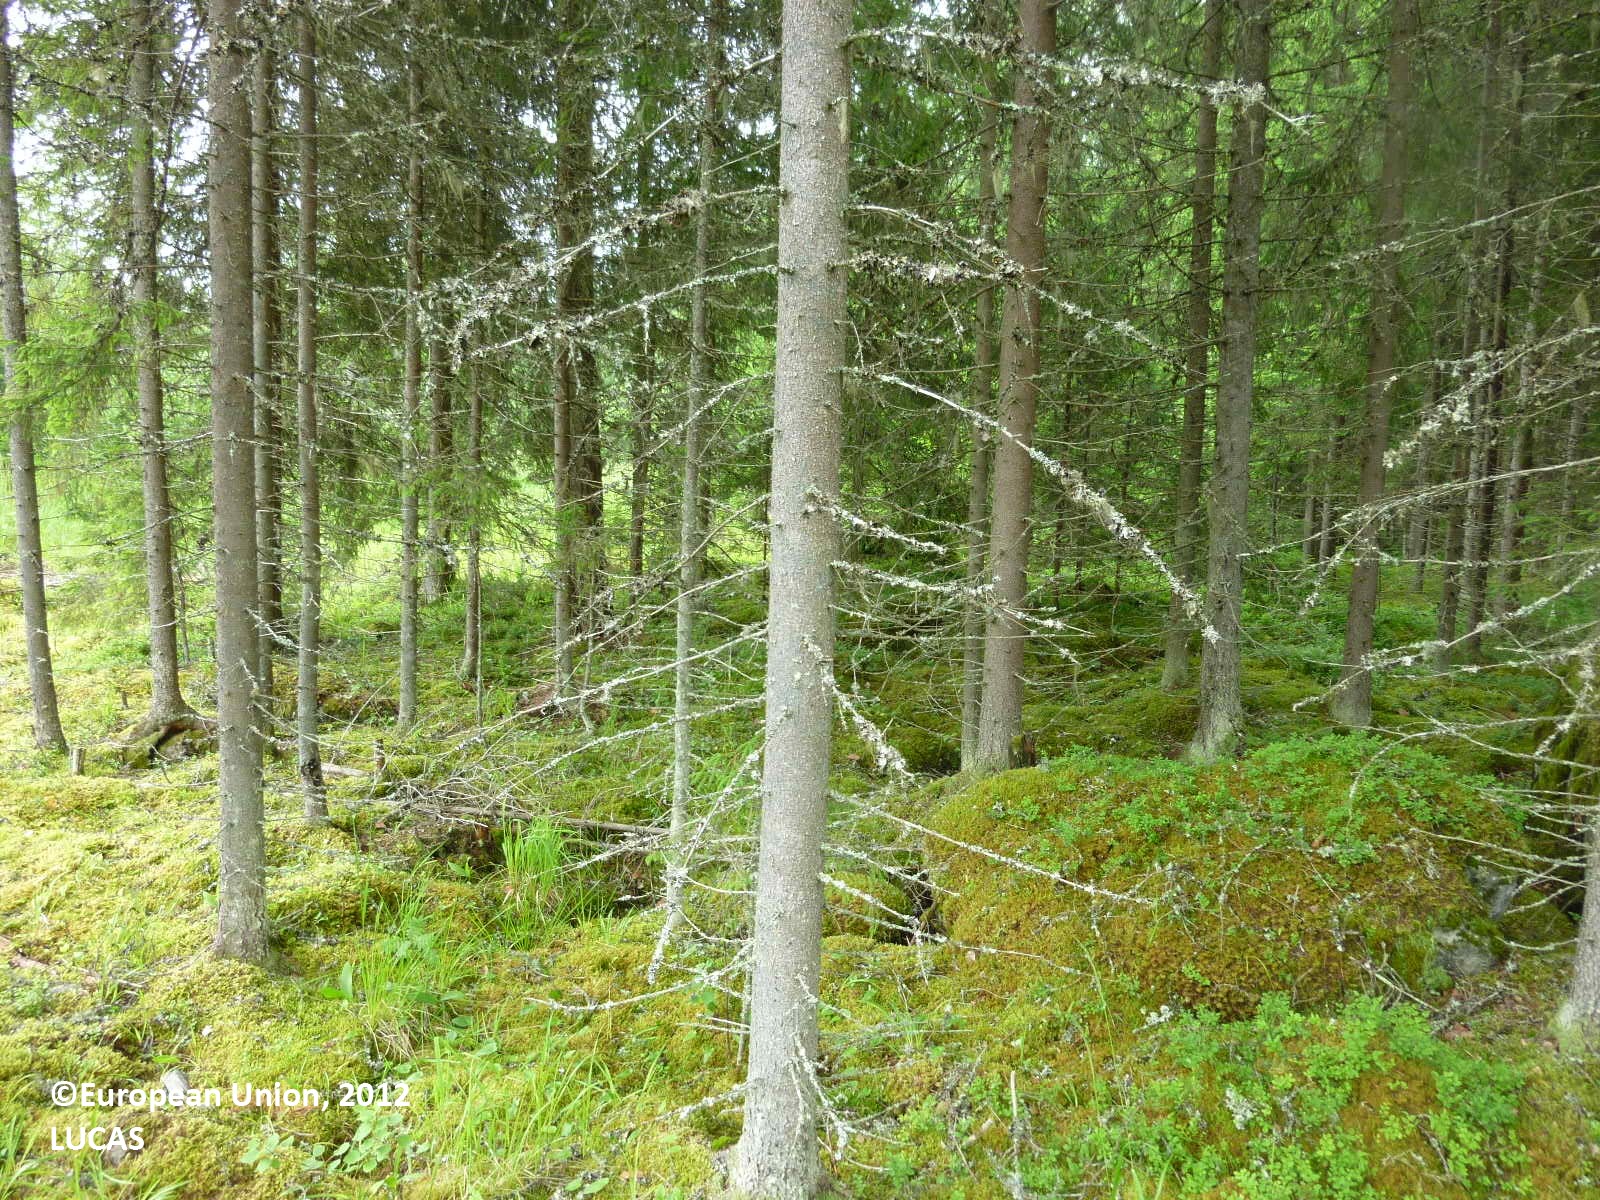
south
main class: Woodland
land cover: Spruce dominated coniferous woodland
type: boreal forest
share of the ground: > 75 %
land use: Forestry
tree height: > 5 m
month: July
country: FI
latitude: 61.6135
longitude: 22.0676
